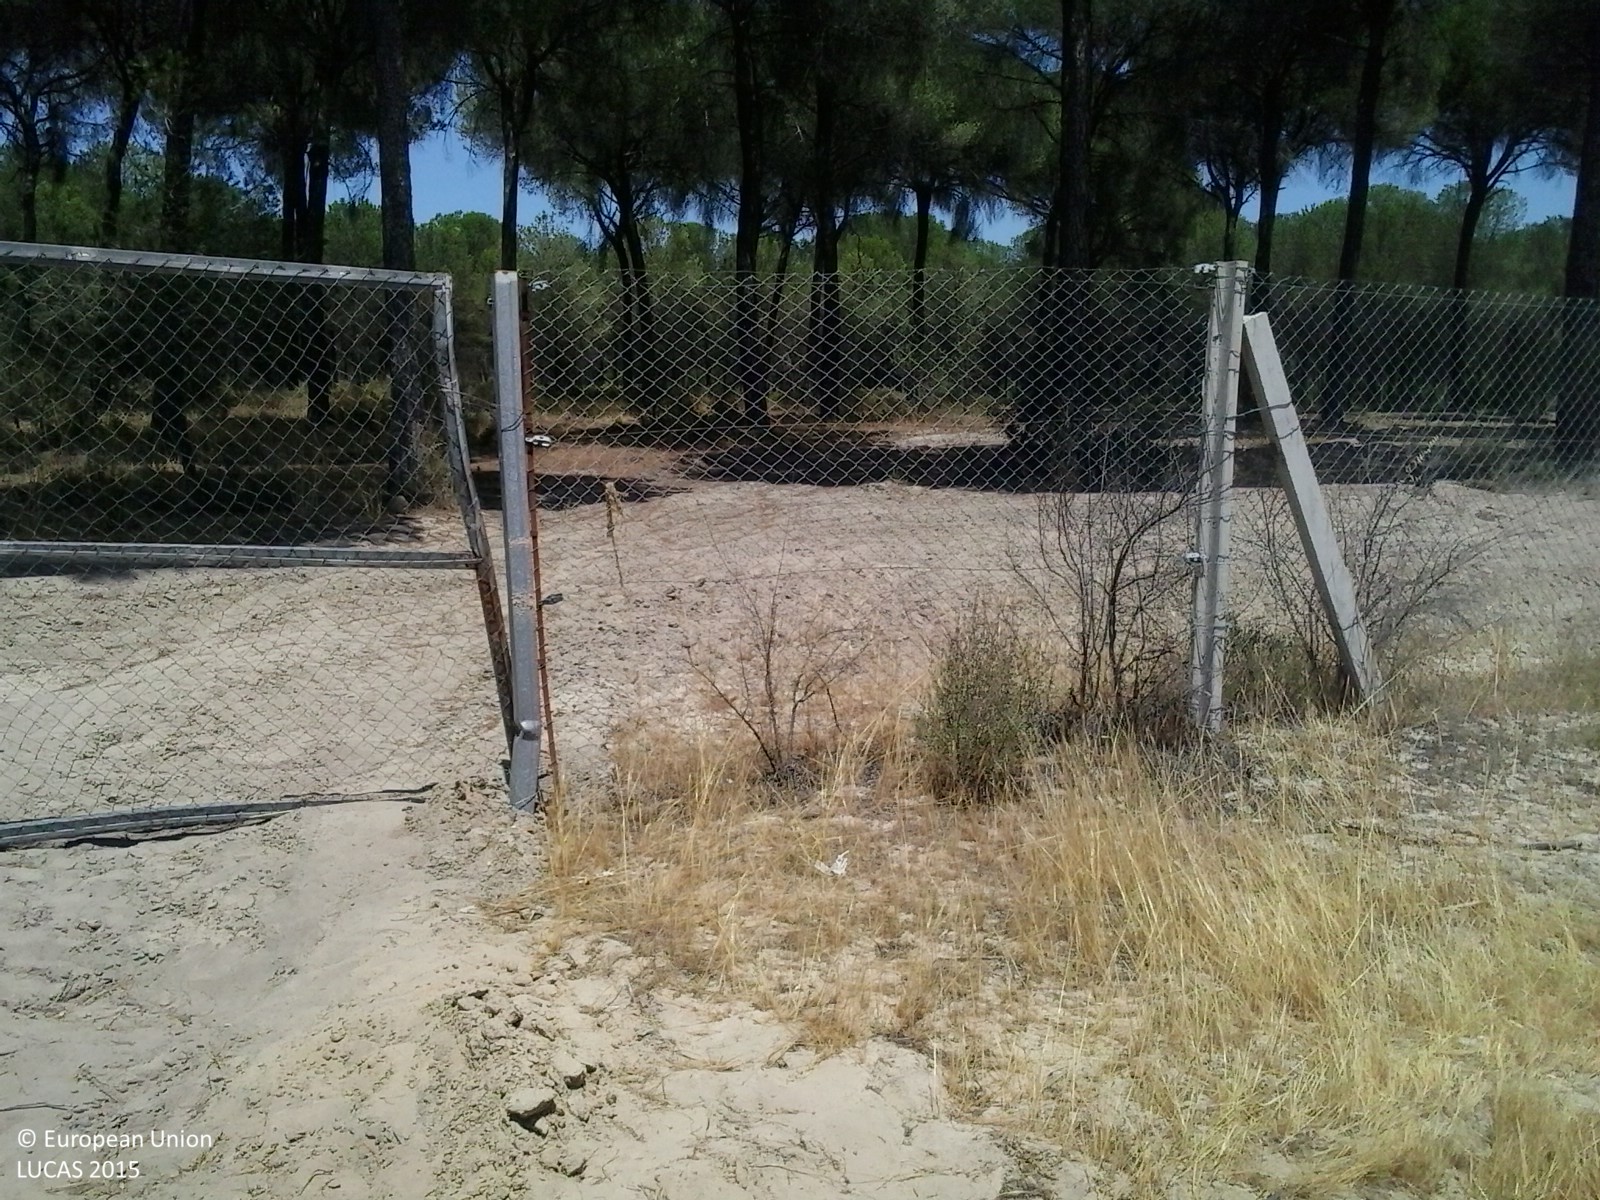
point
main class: Woodland
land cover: Pine dominated coniferous woodland
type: coniferous forest of the mediterranean region
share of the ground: 50 - 75 %
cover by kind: coniferous forest trees 50 %, herbaceous plants 30 %, shrubs 20 %
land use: Forestry
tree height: > 5 m
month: July
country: ES
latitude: 37.2034
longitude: -6.3751
